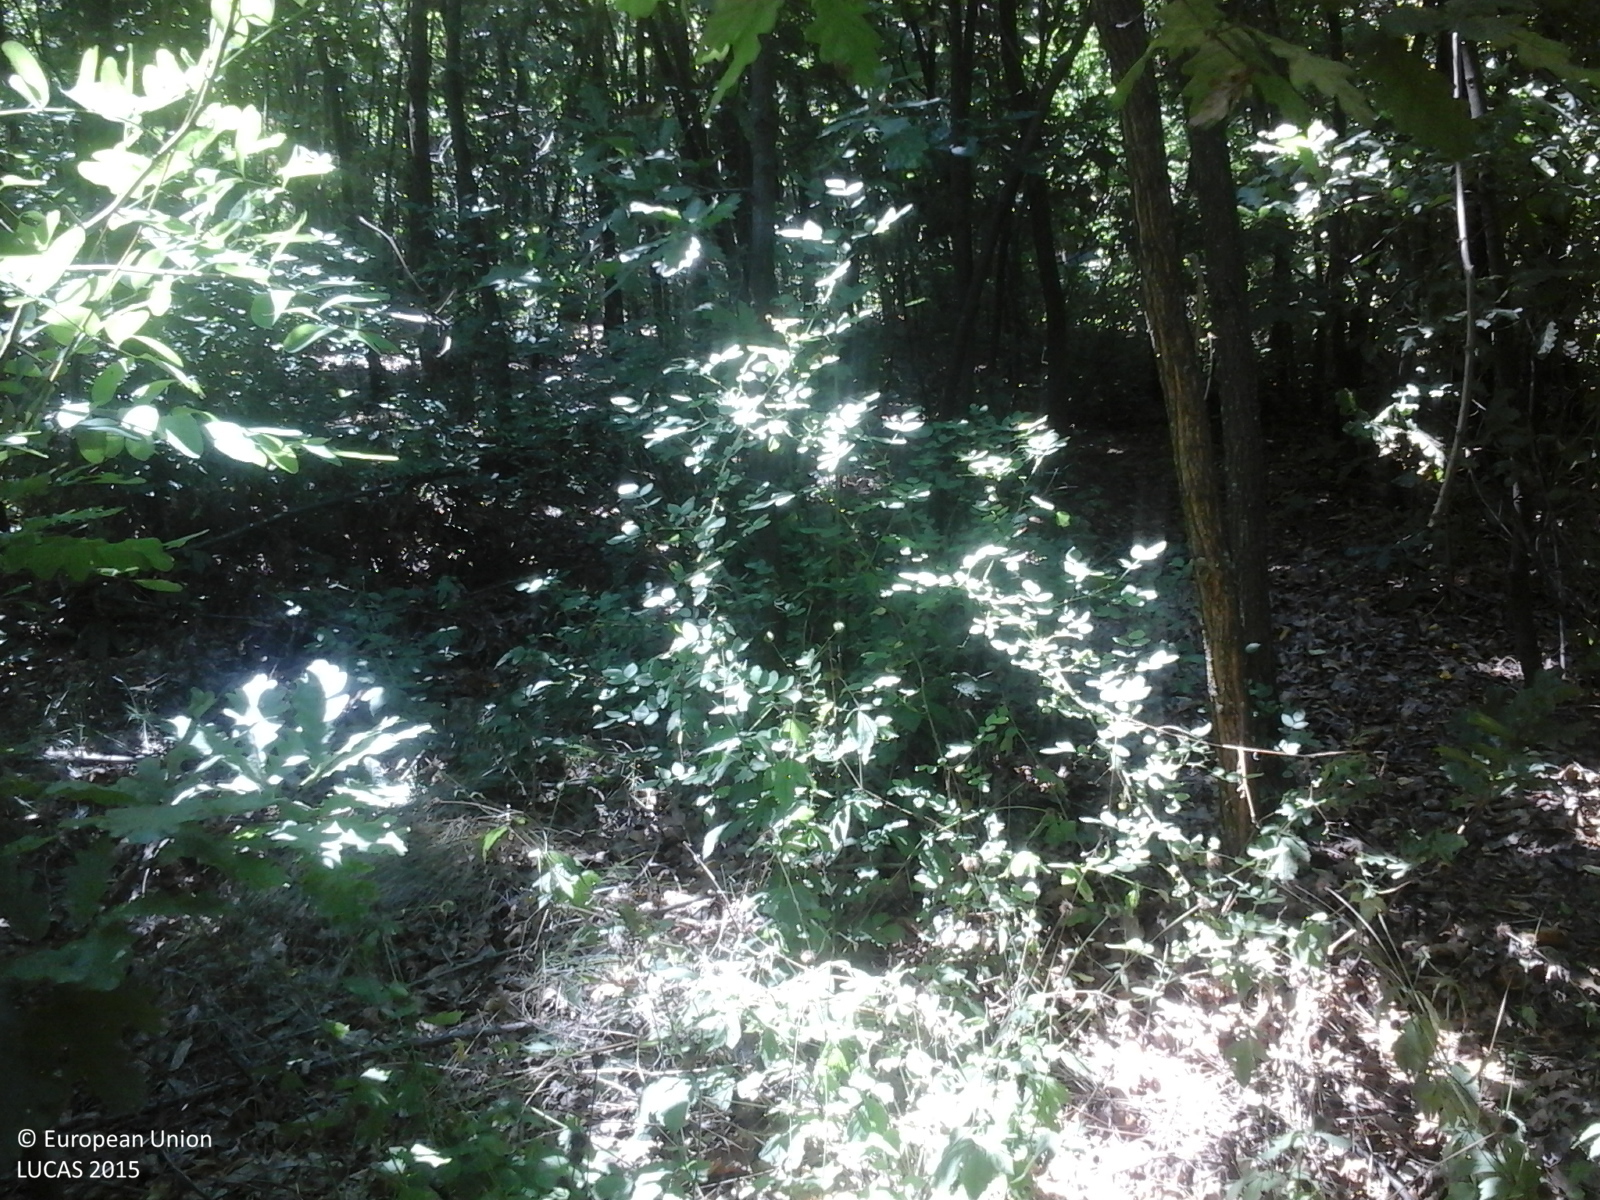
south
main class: Woodland
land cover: Broadleaved woodland
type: mesophytic deciduous forest
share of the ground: > 75 %
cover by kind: broadleaved forest trees 90 %, shrubs 5 %, herbaceous plants 5 %
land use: Forestry
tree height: > 5 m
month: July
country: RO
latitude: 44.2683
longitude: 24.5645
